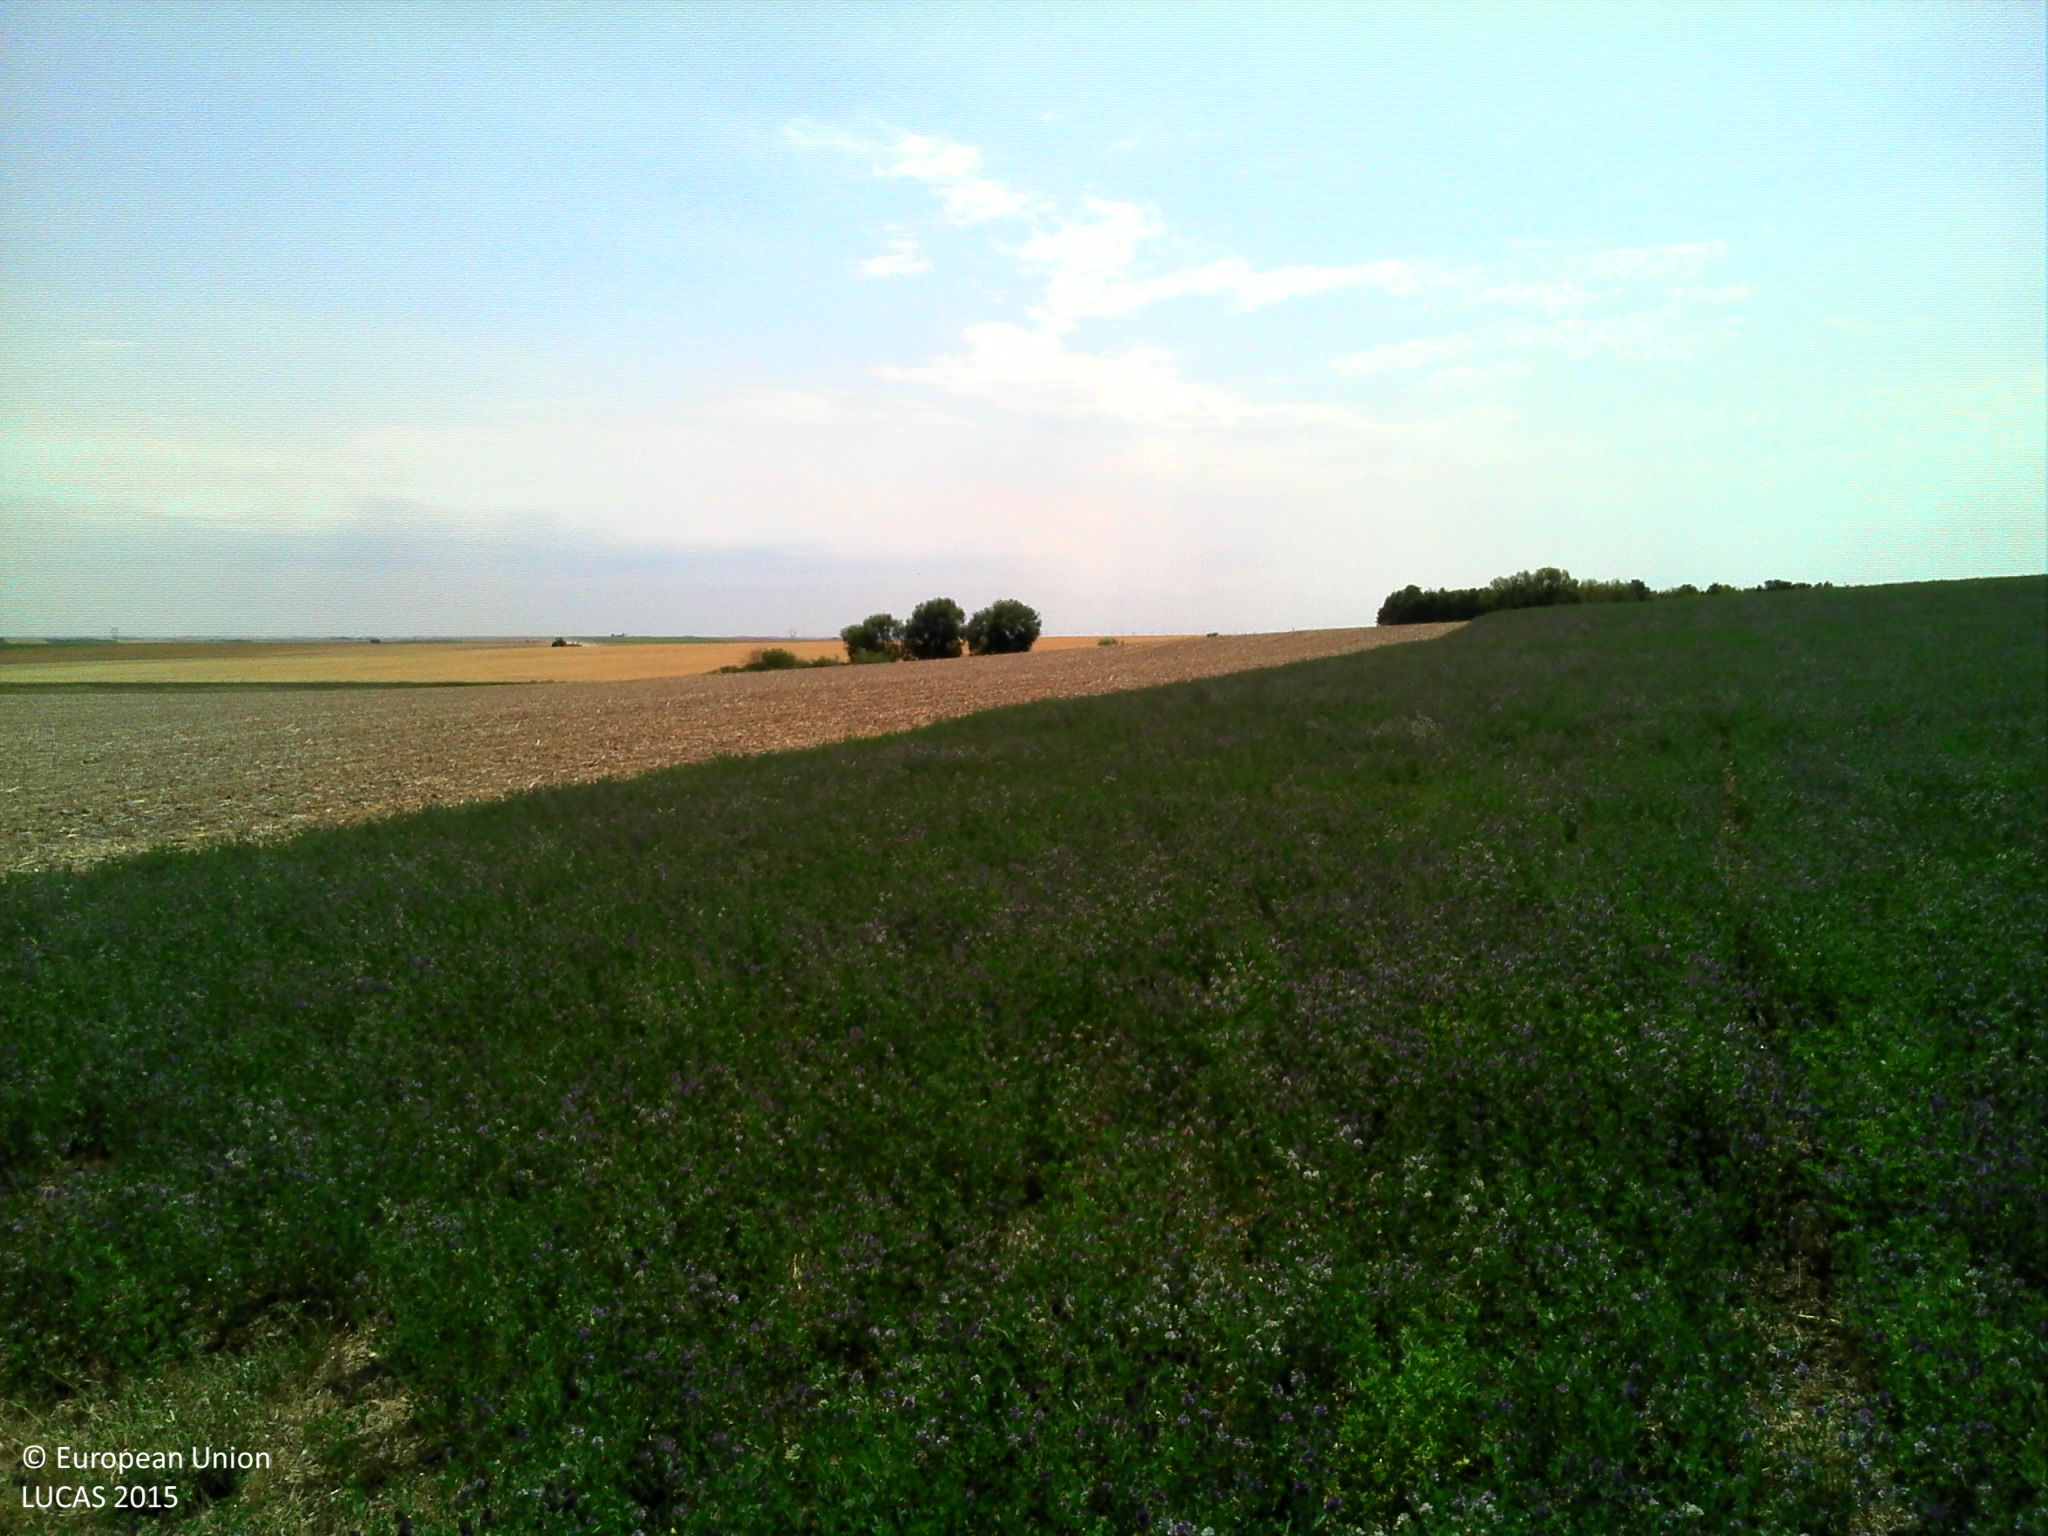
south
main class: Cropland
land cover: Lucerne
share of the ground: > 75 %
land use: Agriculture (excluding fallow land and kitchen gardens)
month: August
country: FR
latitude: 49.0991
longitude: 4.2022
